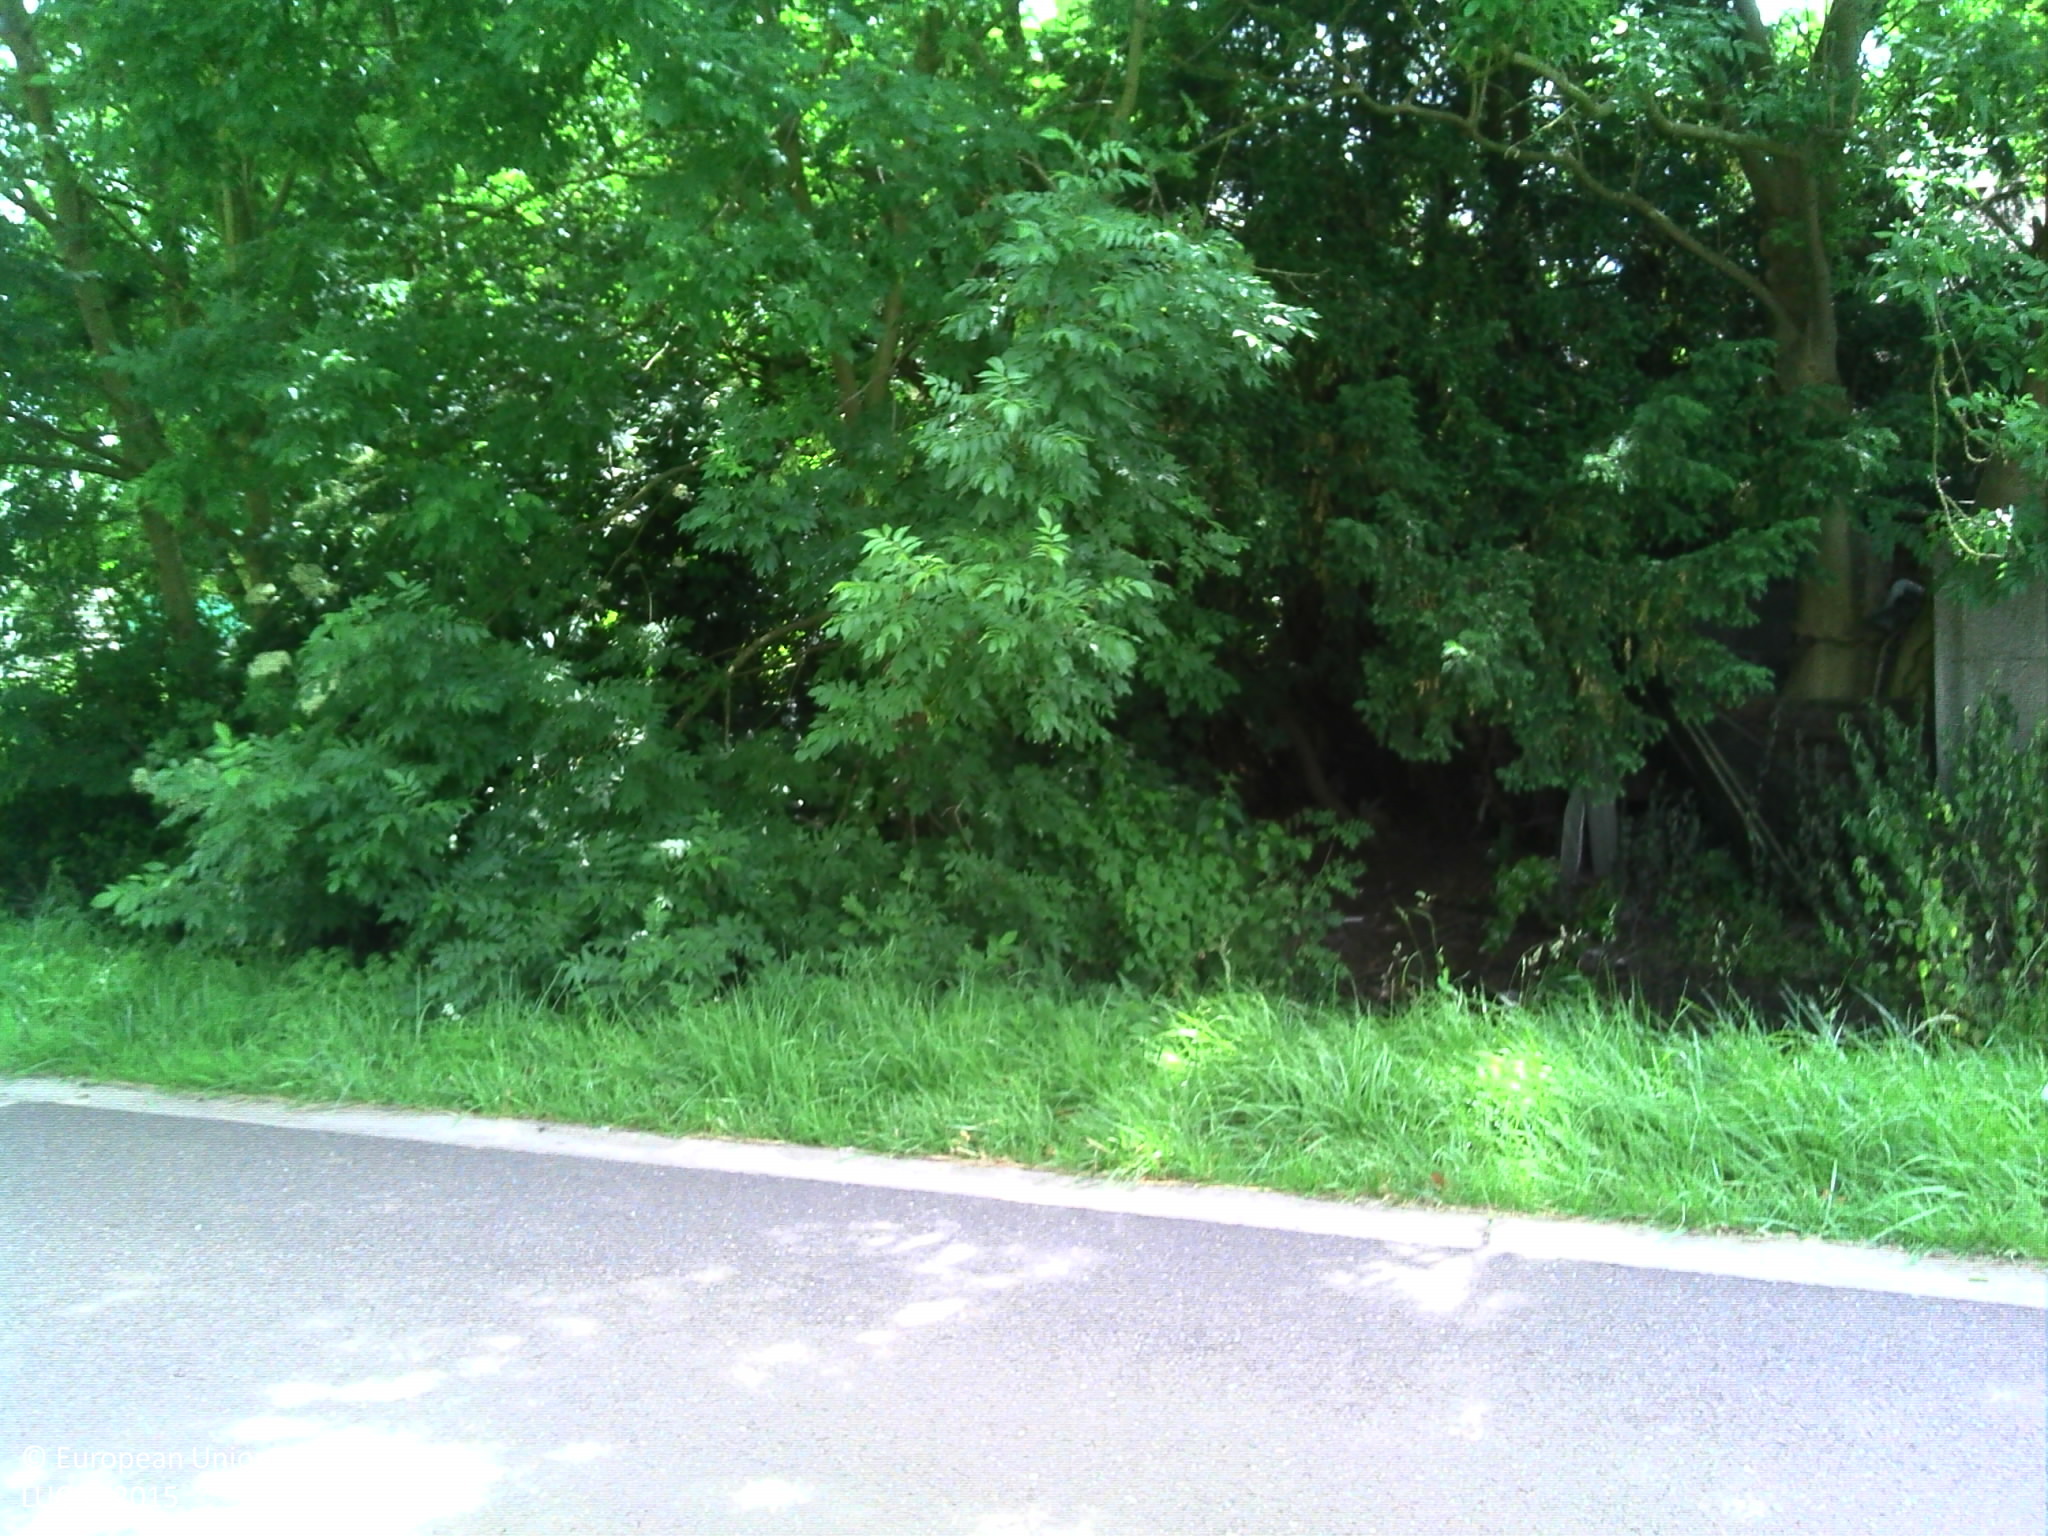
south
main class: Grassland
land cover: Grassland with sparse tree/shrub cover
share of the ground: > 75 %
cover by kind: herbaceous plants 95 %, broadleaved forest trees 5 %
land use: Residential
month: June
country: BE
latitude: 51.2304
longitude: 4.2810
